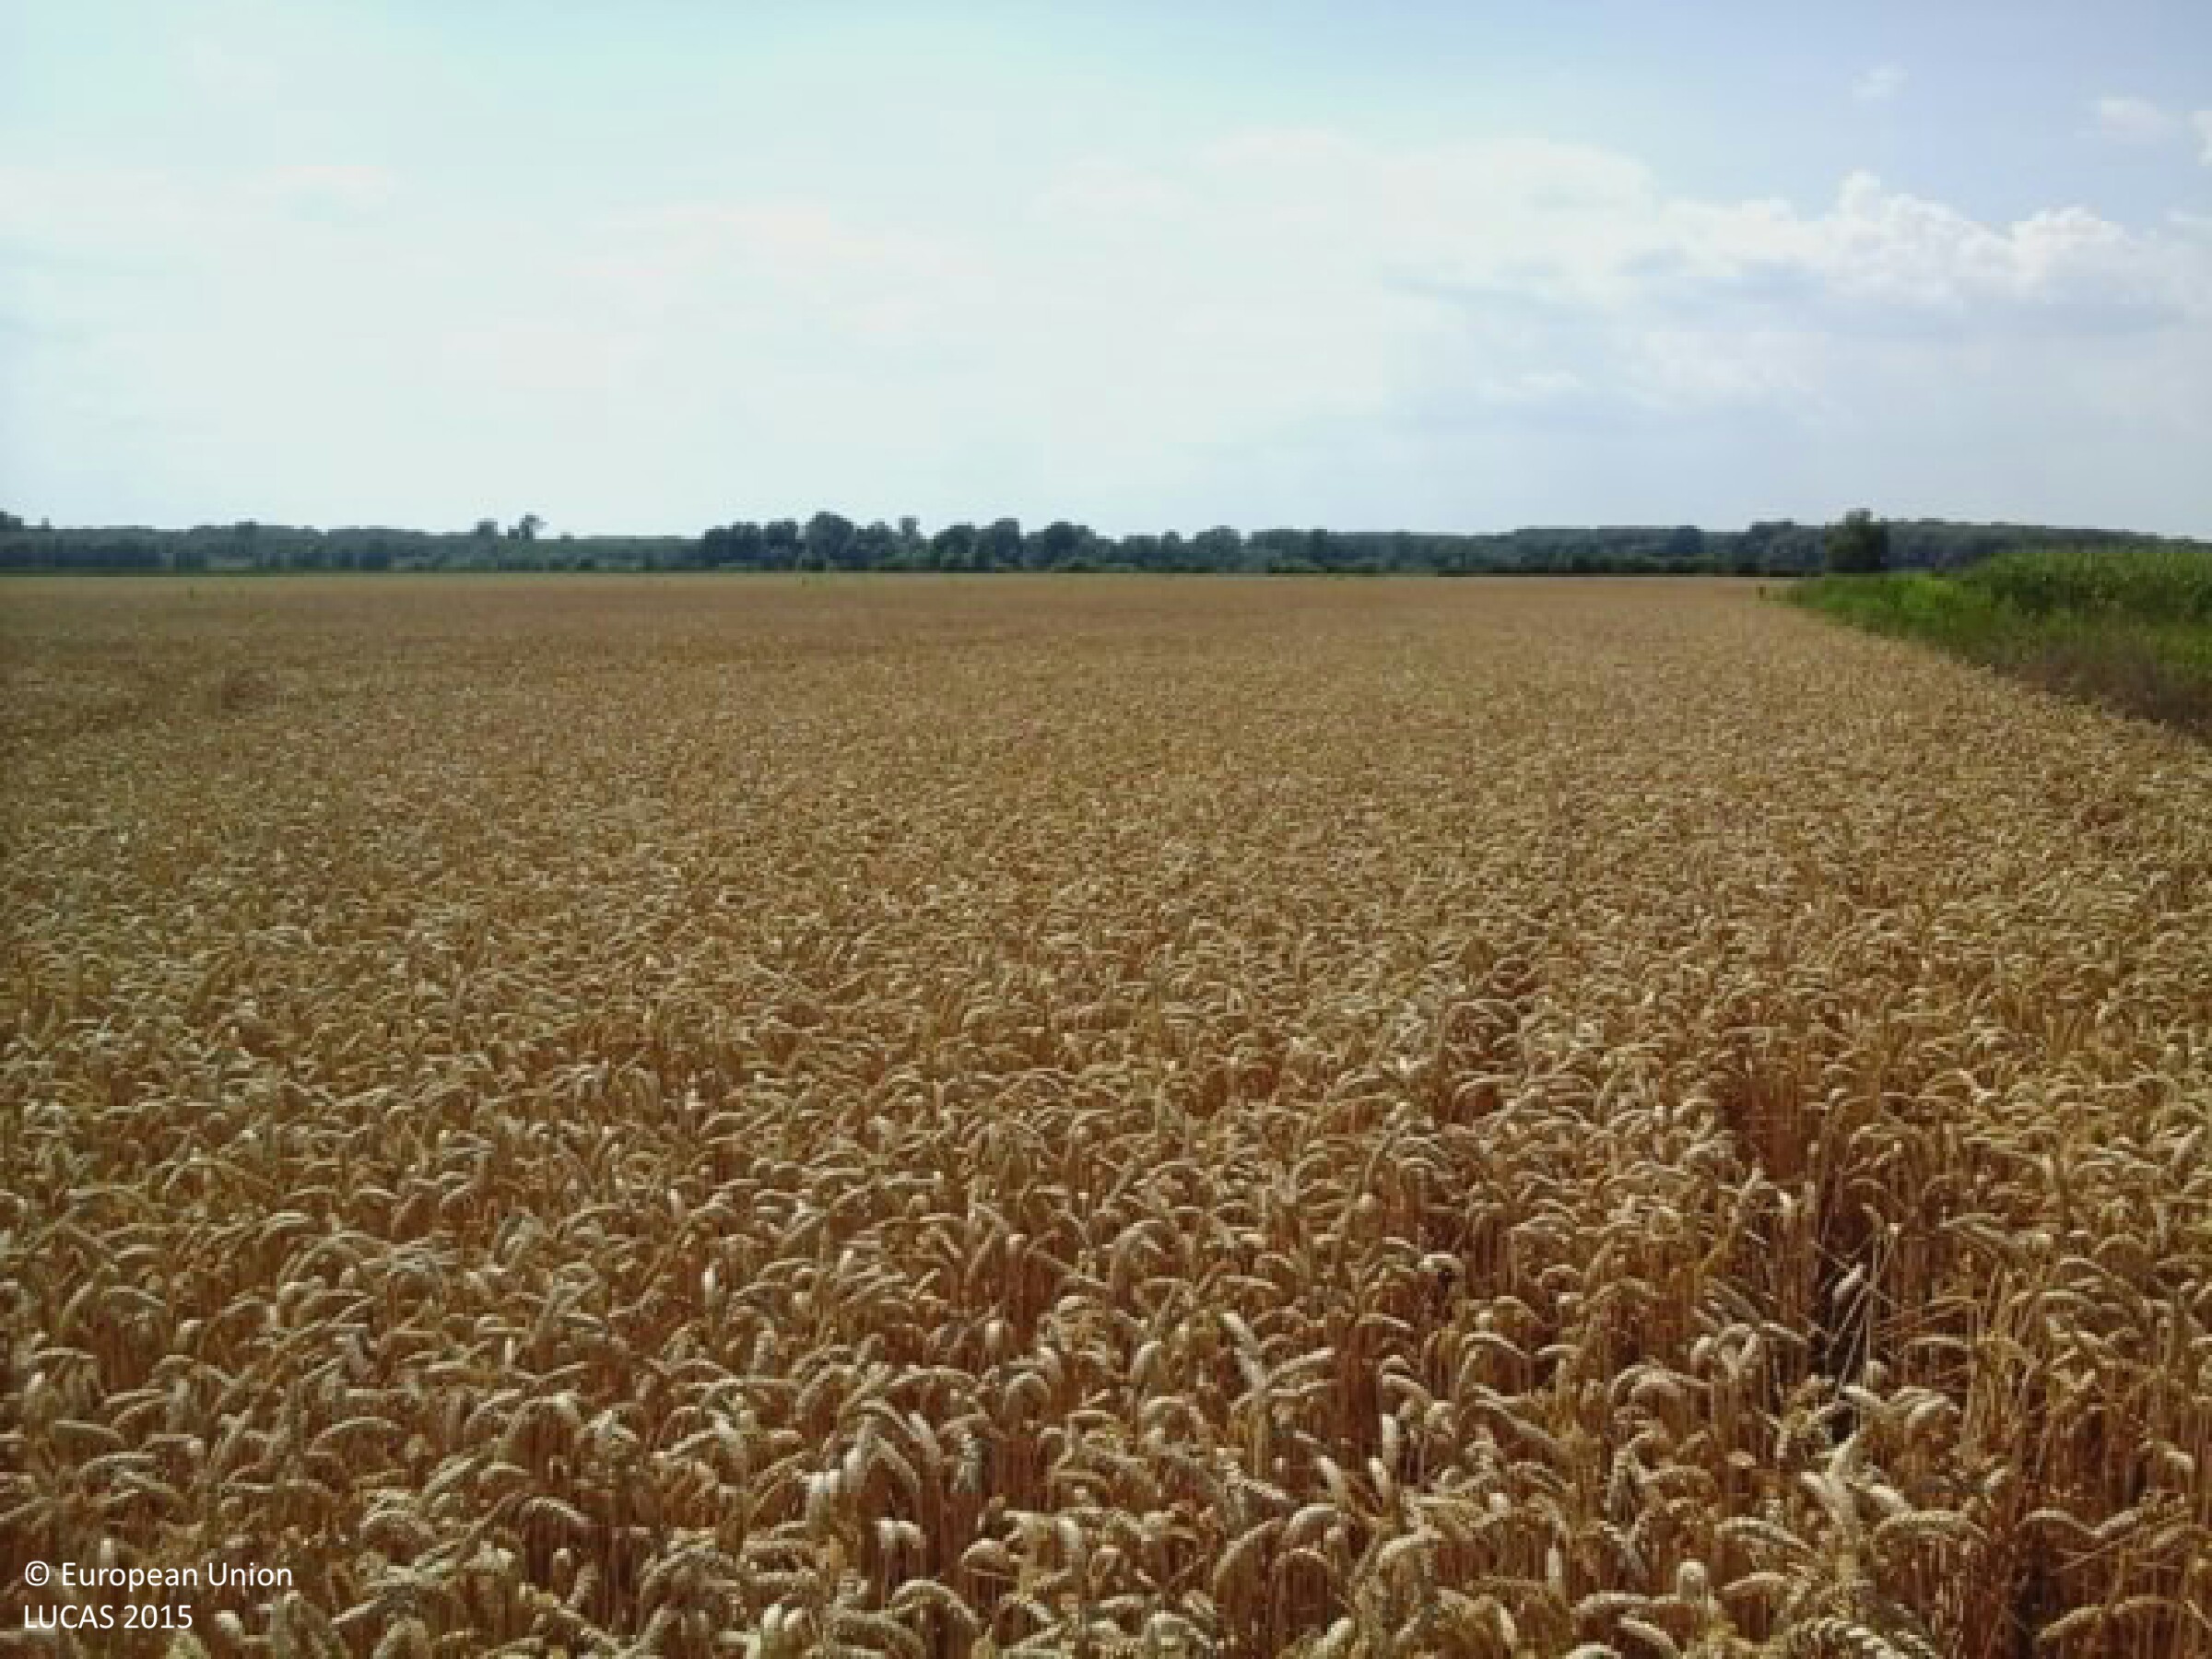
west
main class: Cropland
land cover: Common wheat
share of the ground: > 75 %
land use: Agriculture (excluding fallow land and kitchen gardens)
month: July
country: HU
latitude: 45.9121
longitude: 18.8412
